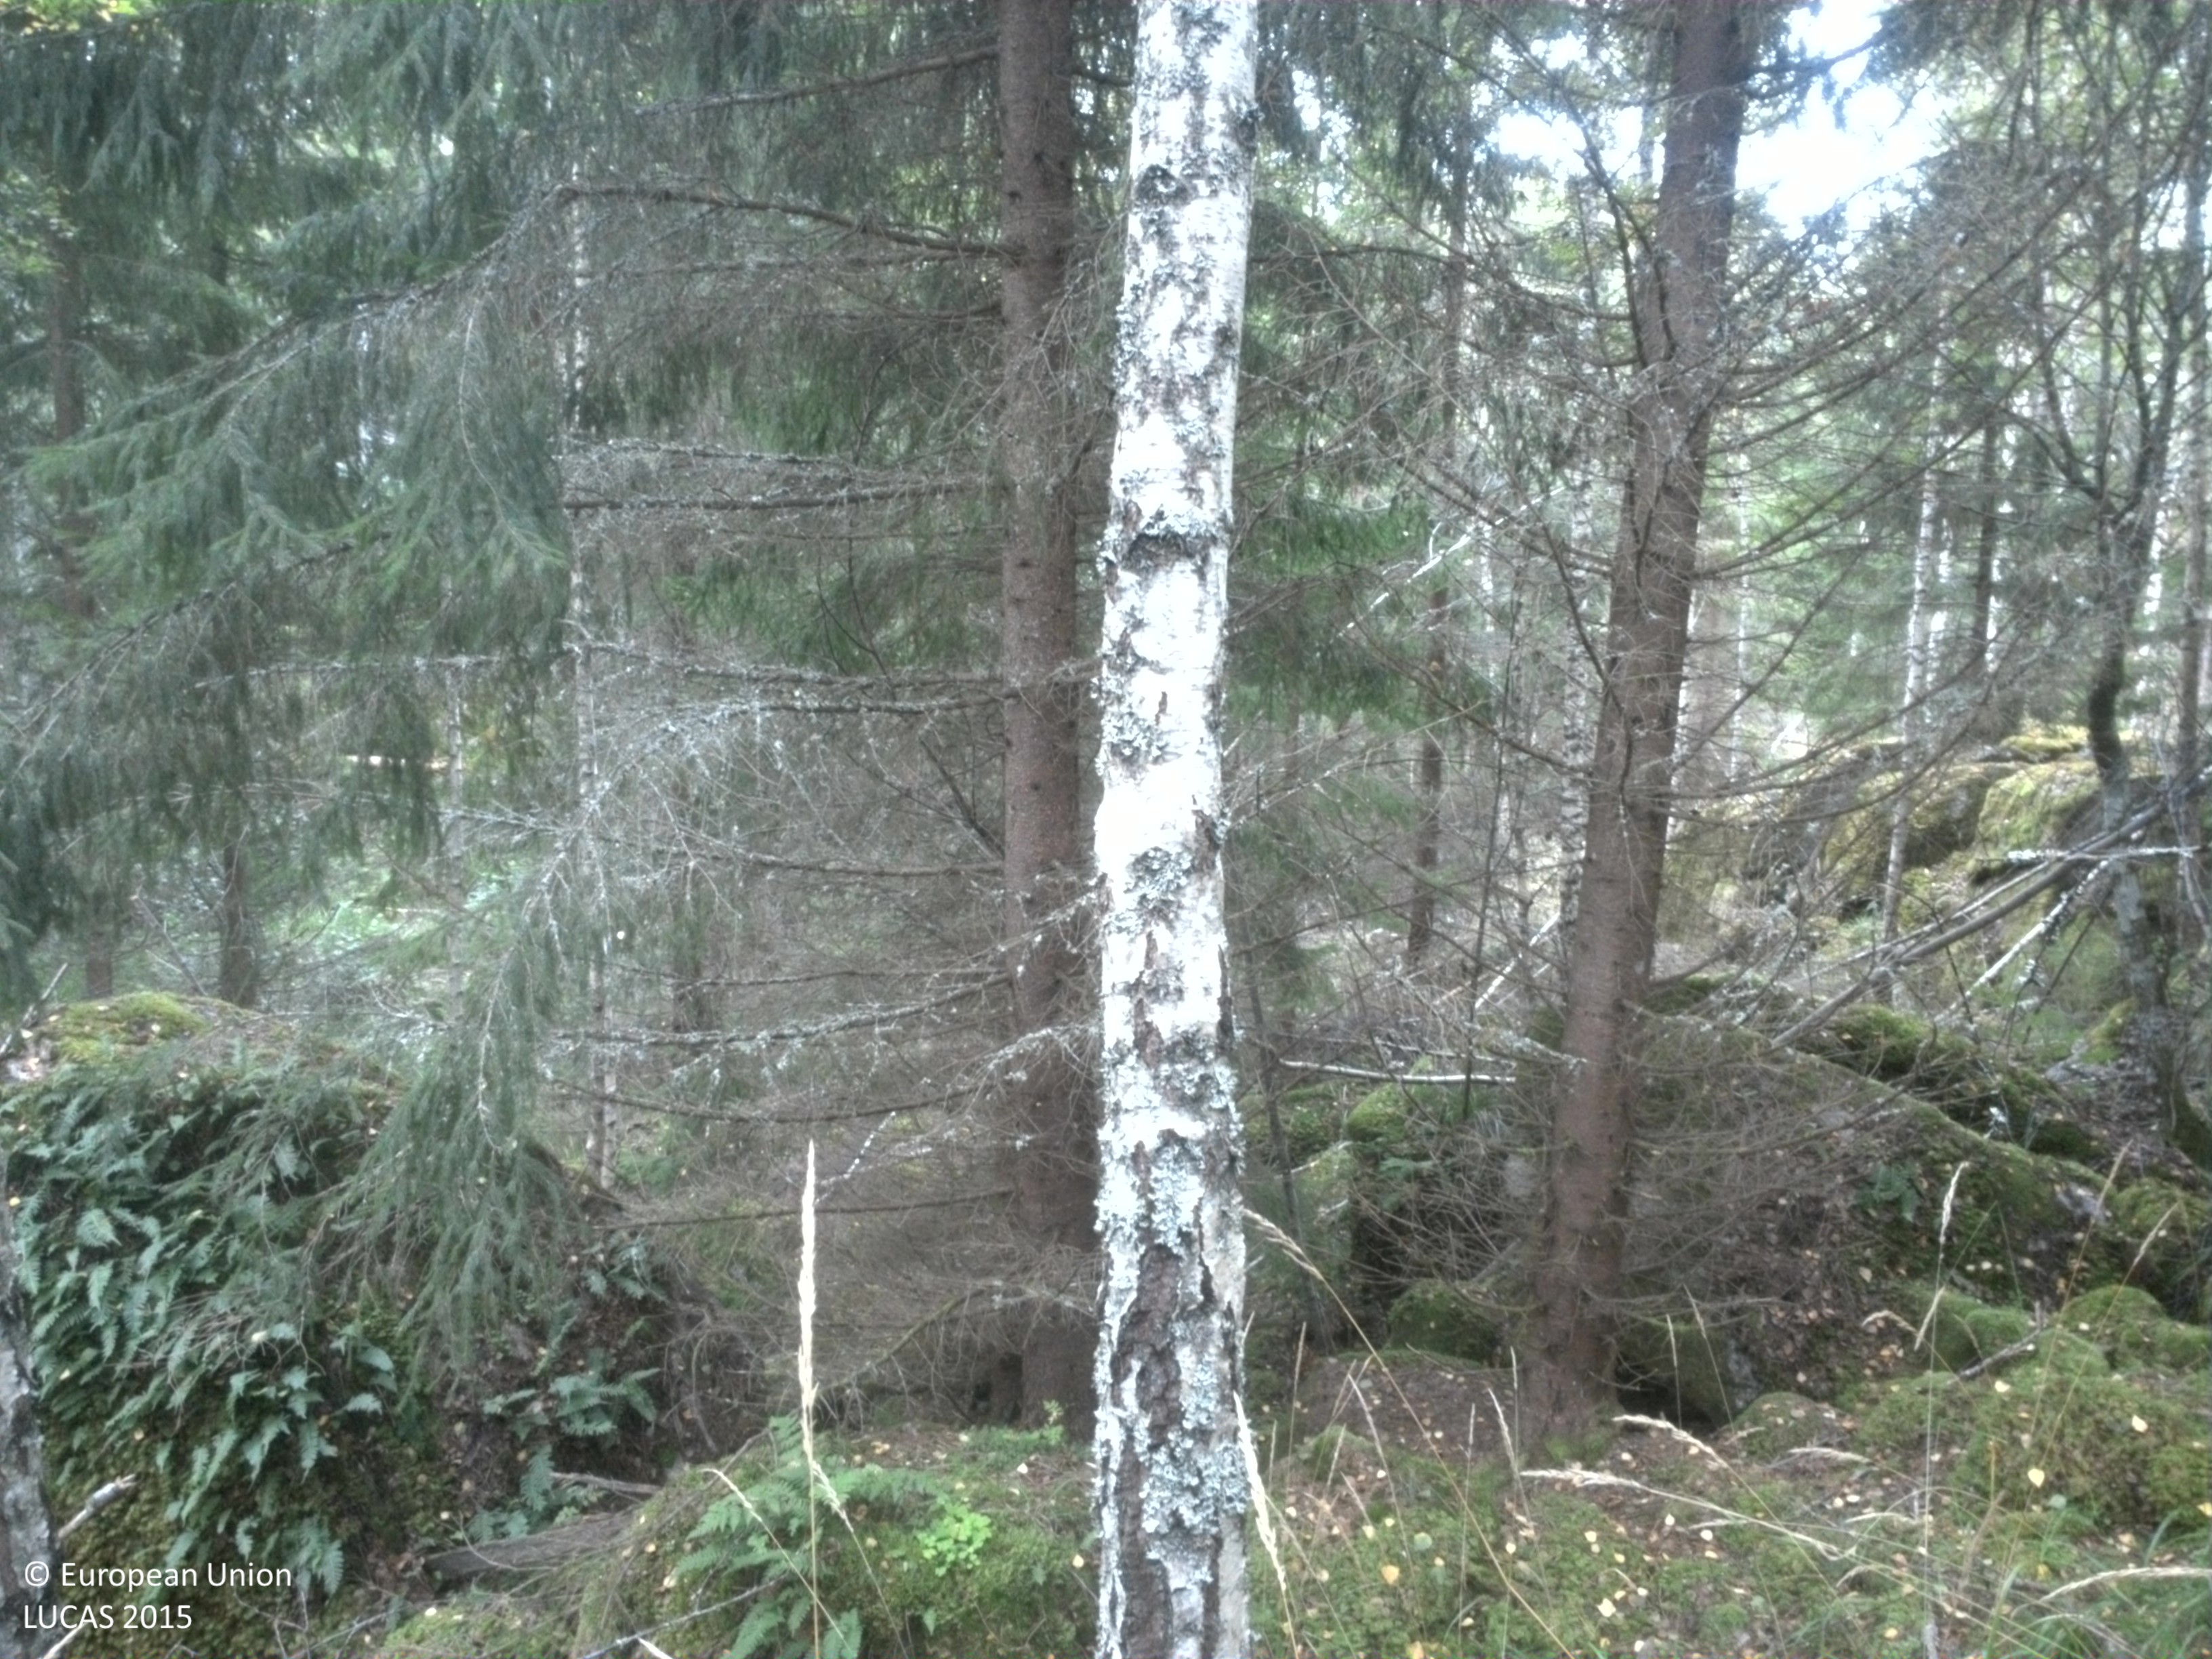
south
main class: Woodland
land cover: Spruce dominated mixed woodland
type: boreal forest
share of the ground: 50 - 75 %
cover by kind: coniferous forest trees 40 %, broadleaved forest trees 30 %, lichens and mosses 15 %, herbaceous plants 10 %, shrubs 5 %
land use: Forestry
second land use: Amenities, museums, leisure
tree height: > 5 m
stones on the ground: 25 - 50 %
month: September
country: SE
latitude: 59.5806
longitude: 15.6393
